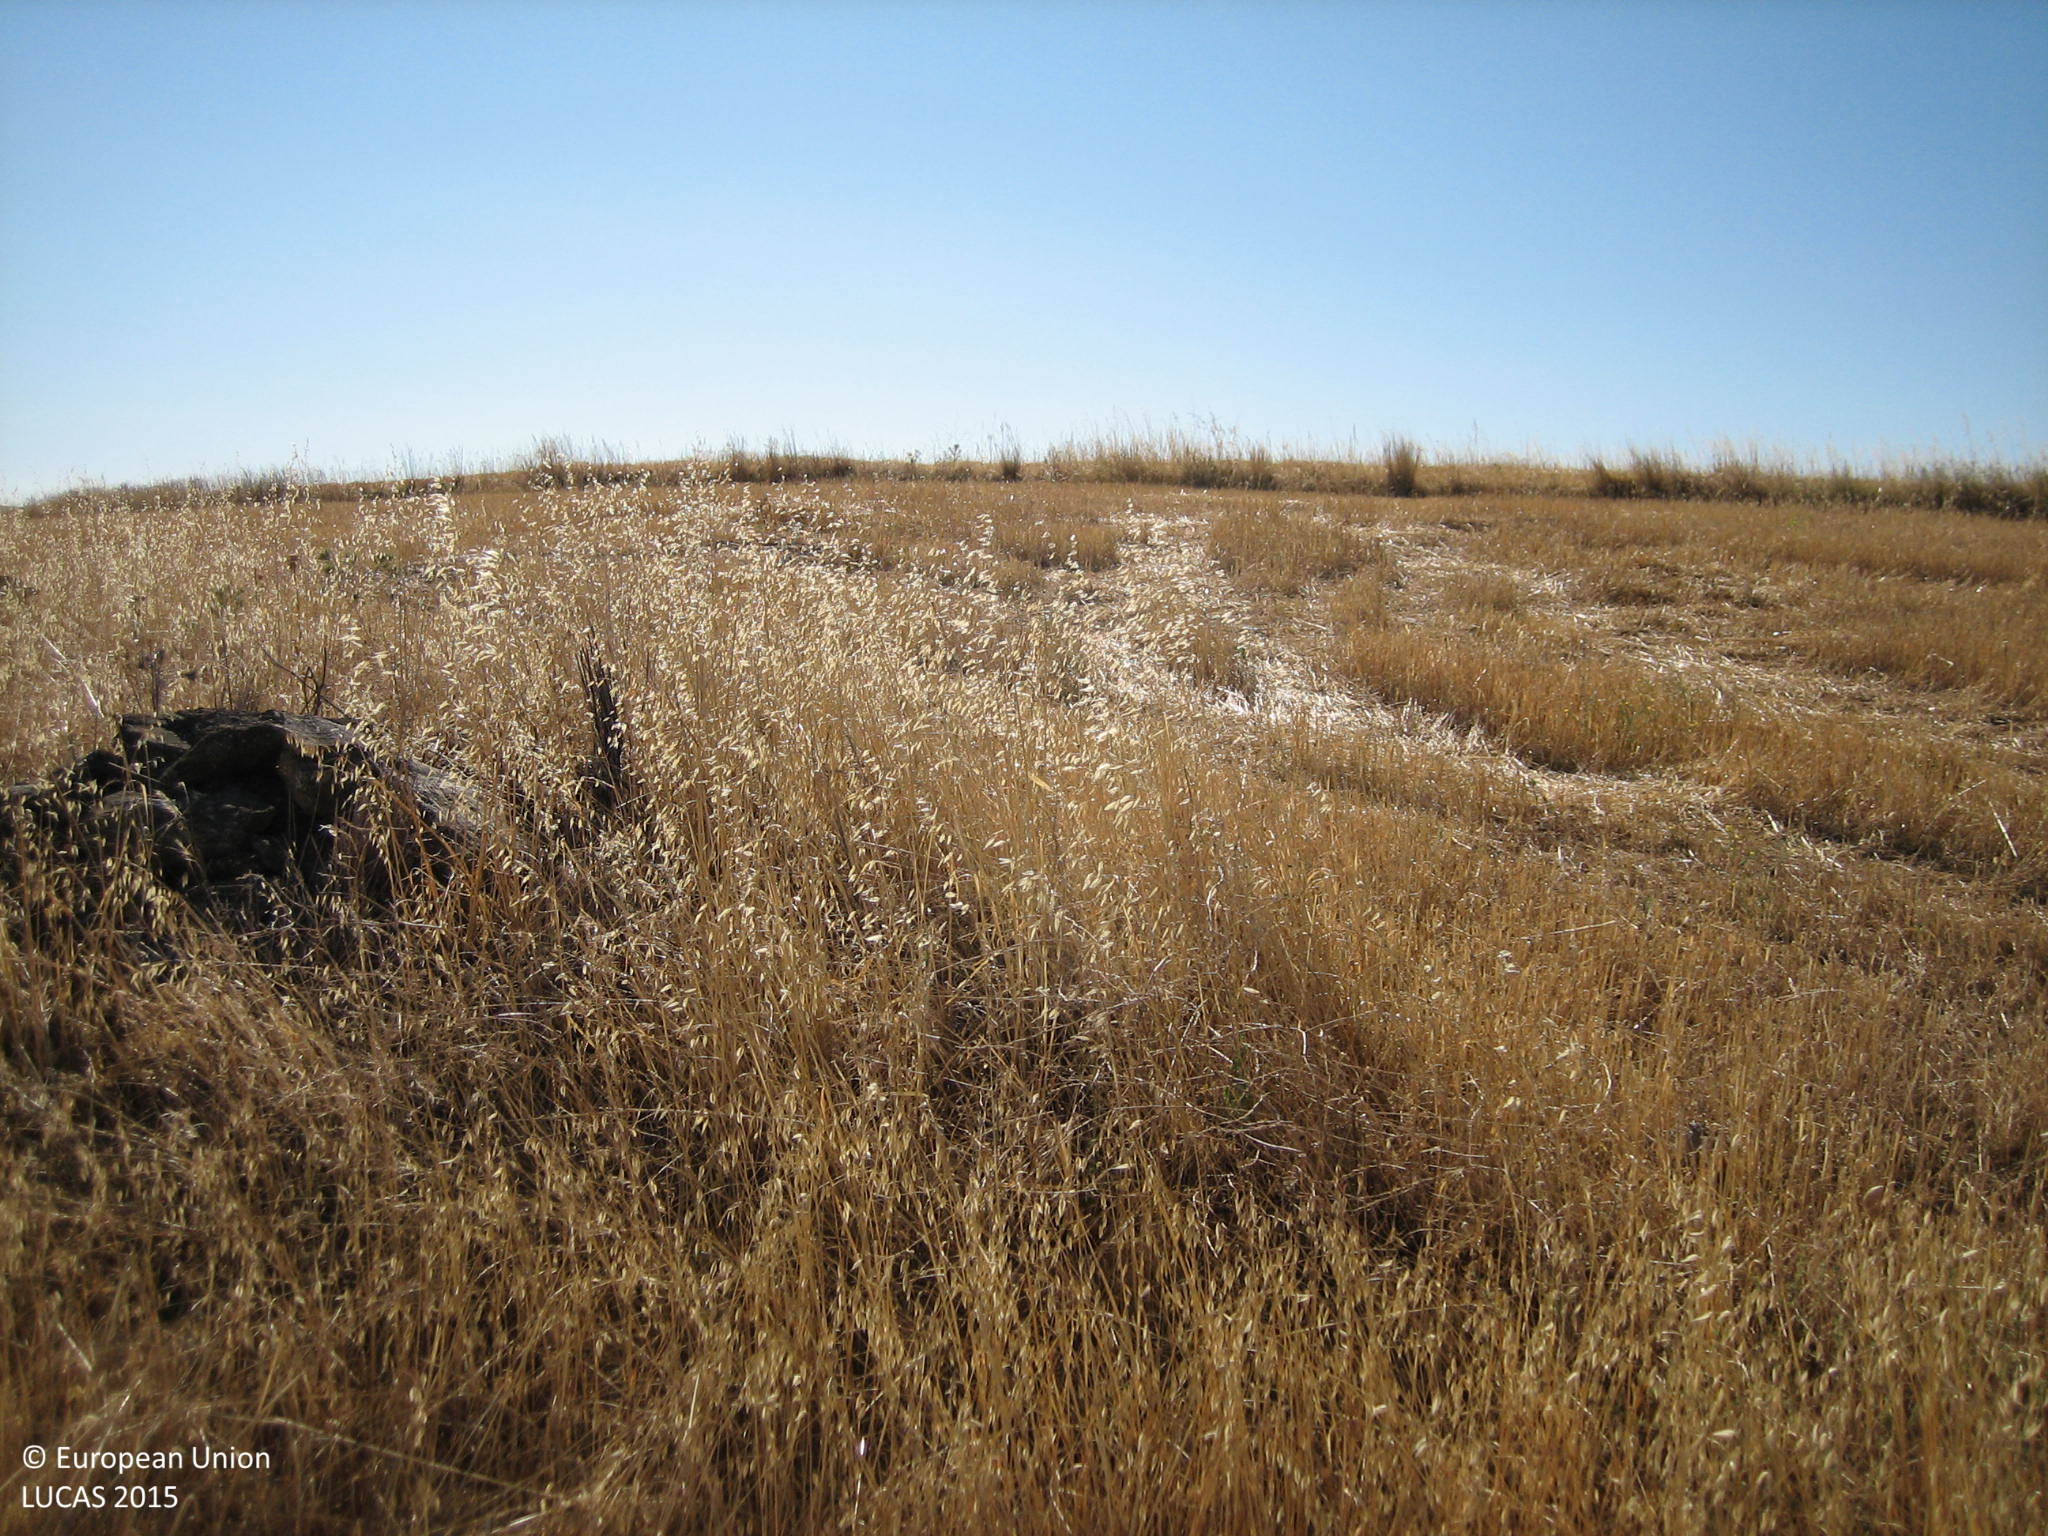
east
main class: Cropland
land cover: Oats
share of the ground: < 10 %
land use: Agriculture (excluding fallow land and kitchen gardens)
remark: Harvested field
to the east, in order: Oats; Grass margins; Oats; Grass margins; Oats; Grass margins; Other bare soil; Grass margins; Oats; Grass margins; Other bare soil; Grass margins; Common wheat
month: July
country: ES
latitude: 38.3356
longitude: -6.1169
